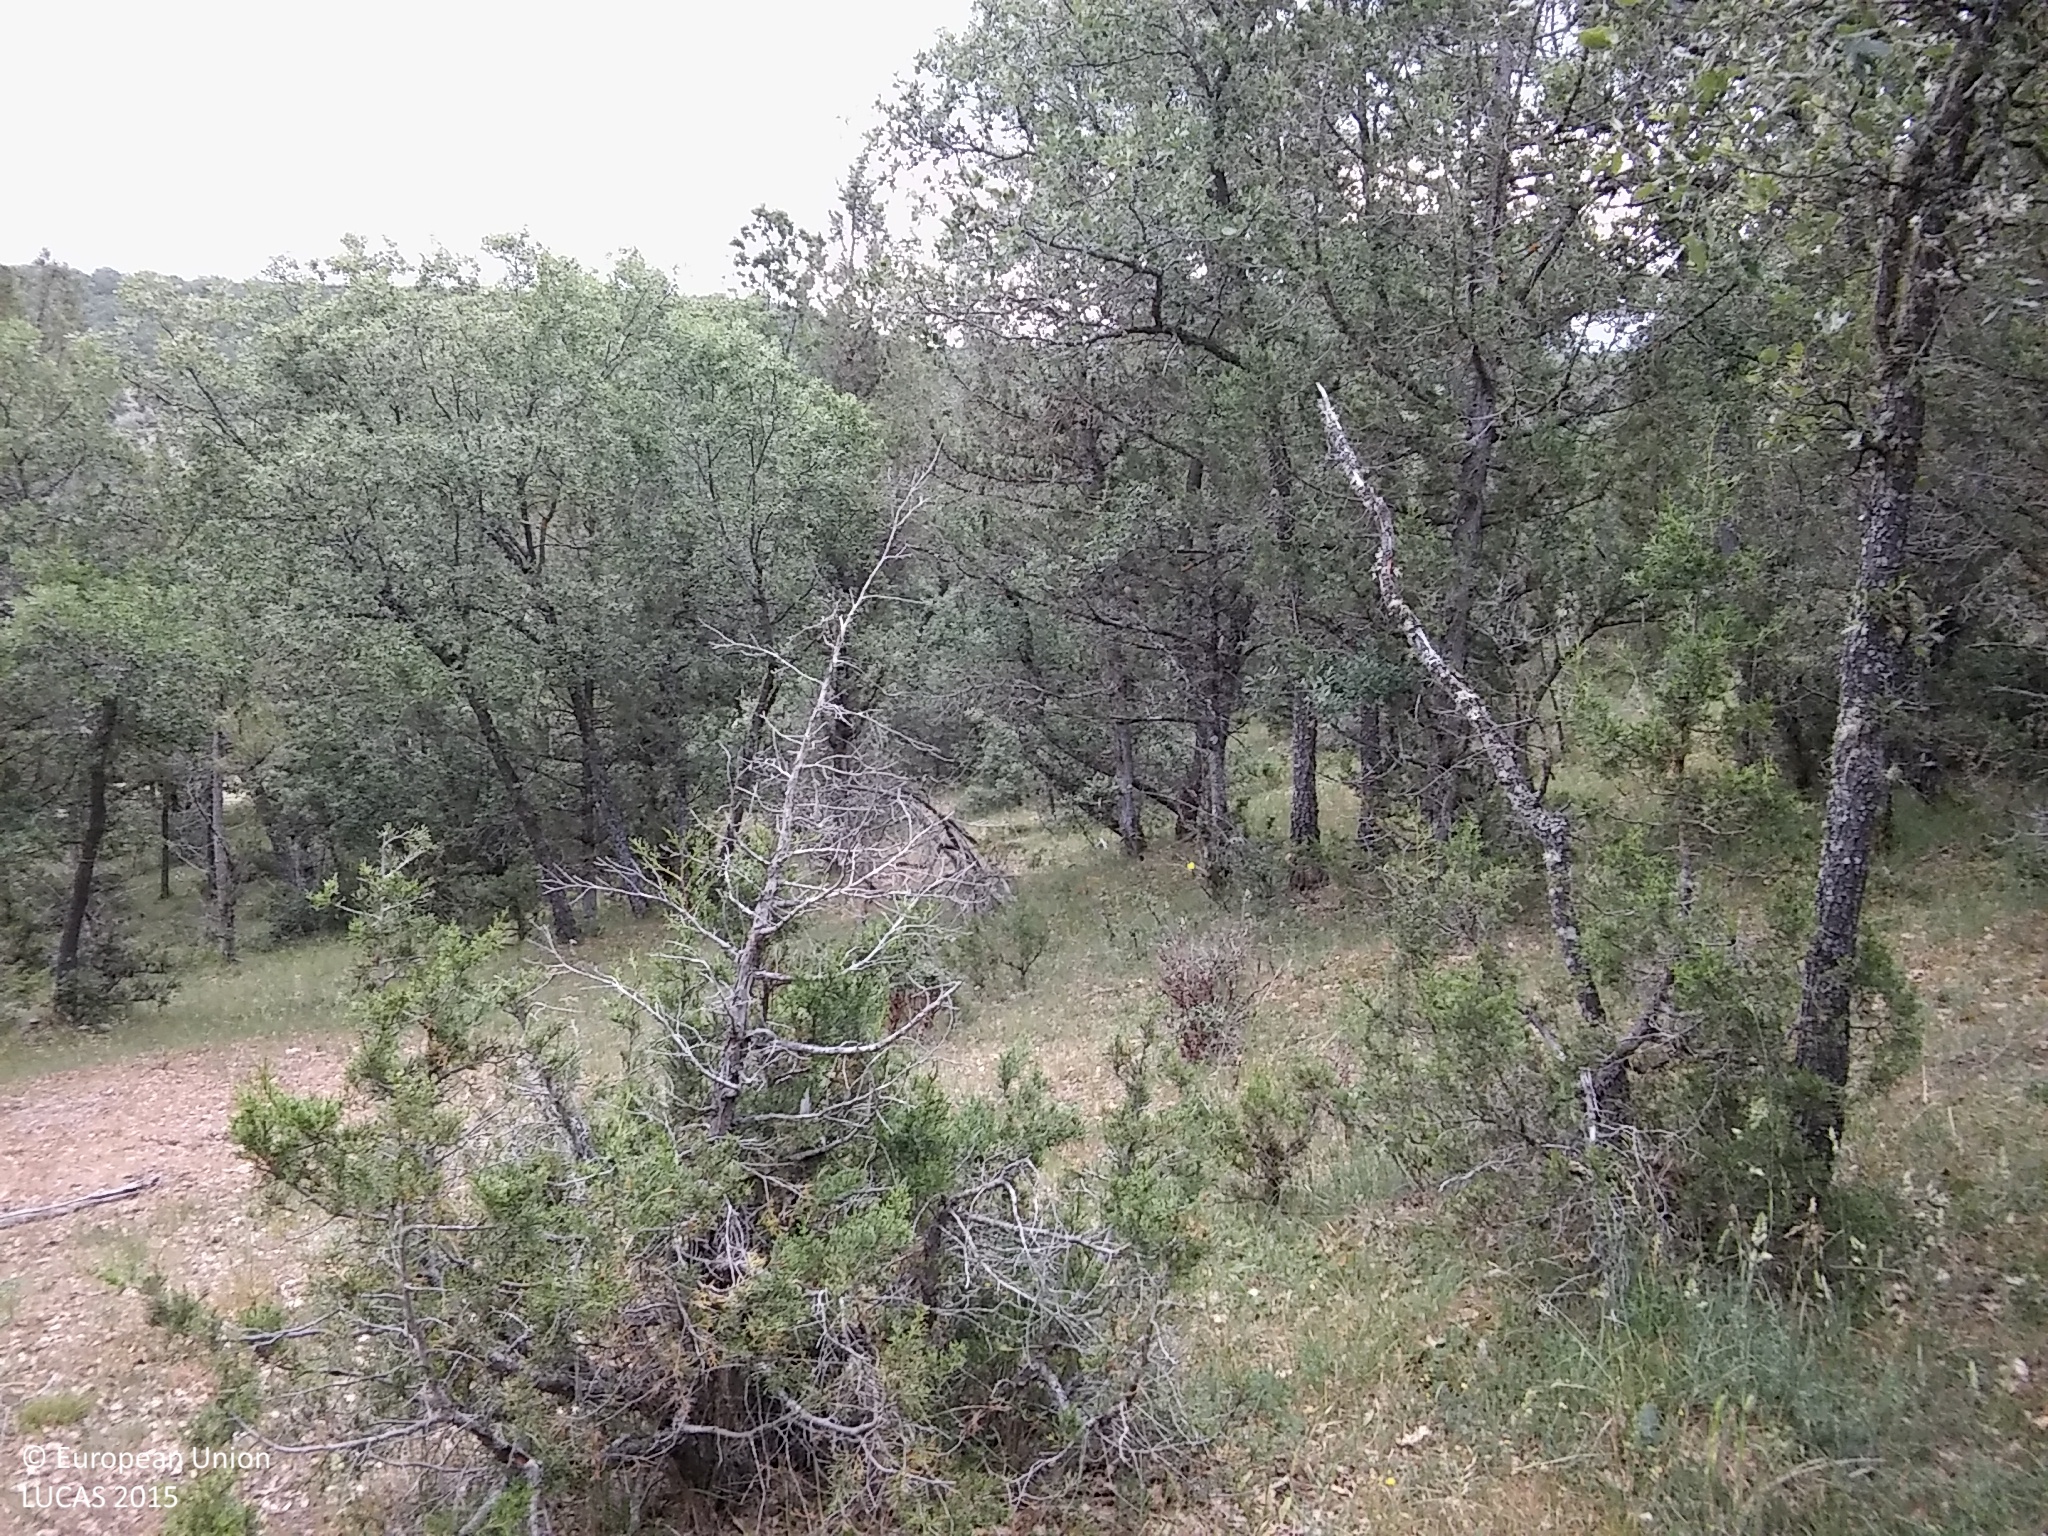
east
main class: Woodland
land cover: Broadleaved woodland
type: acidophilous oak and oak-birch forest
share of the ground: 50 - 75 %
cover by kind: broadleaved forest trees 70 %, herbaceous plants 15 %, unconsolidated bare surface 10 %, shrubs 5 %
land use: Agriculture (excluding fallow land and kitchen gardens)
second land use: Forestry
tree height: > 5 m
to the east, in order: Broadleaved woodland; Shrubland with sparse tree cover; Tracks; Shrubland without tree cover; Broadleaved woodland
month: June
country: ES
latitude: 41.2153
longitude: -3.6318
